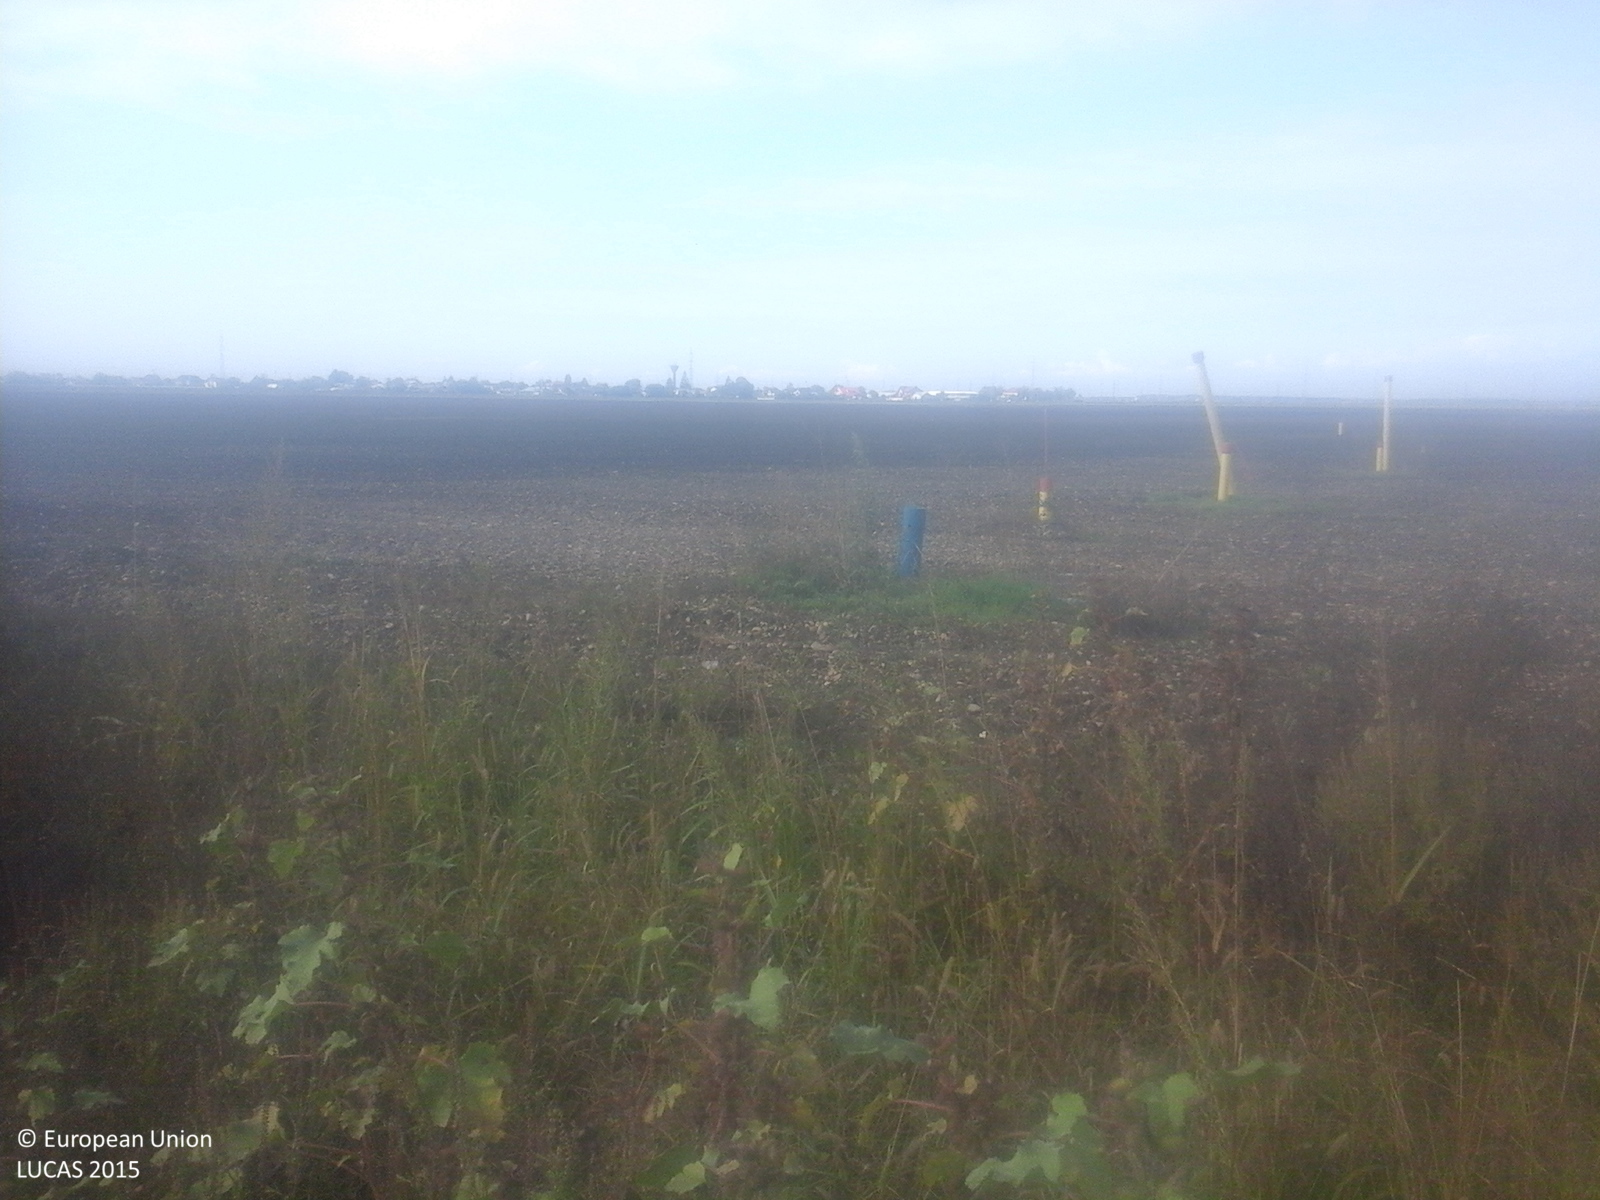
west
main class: Grassland
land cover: Spontaneously vegetated surfaces
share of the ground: > 75 %
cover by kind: herbaceous plants 100 %
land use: Fallow land
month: October
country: RO
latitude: 44.8807
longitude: 25.9948
